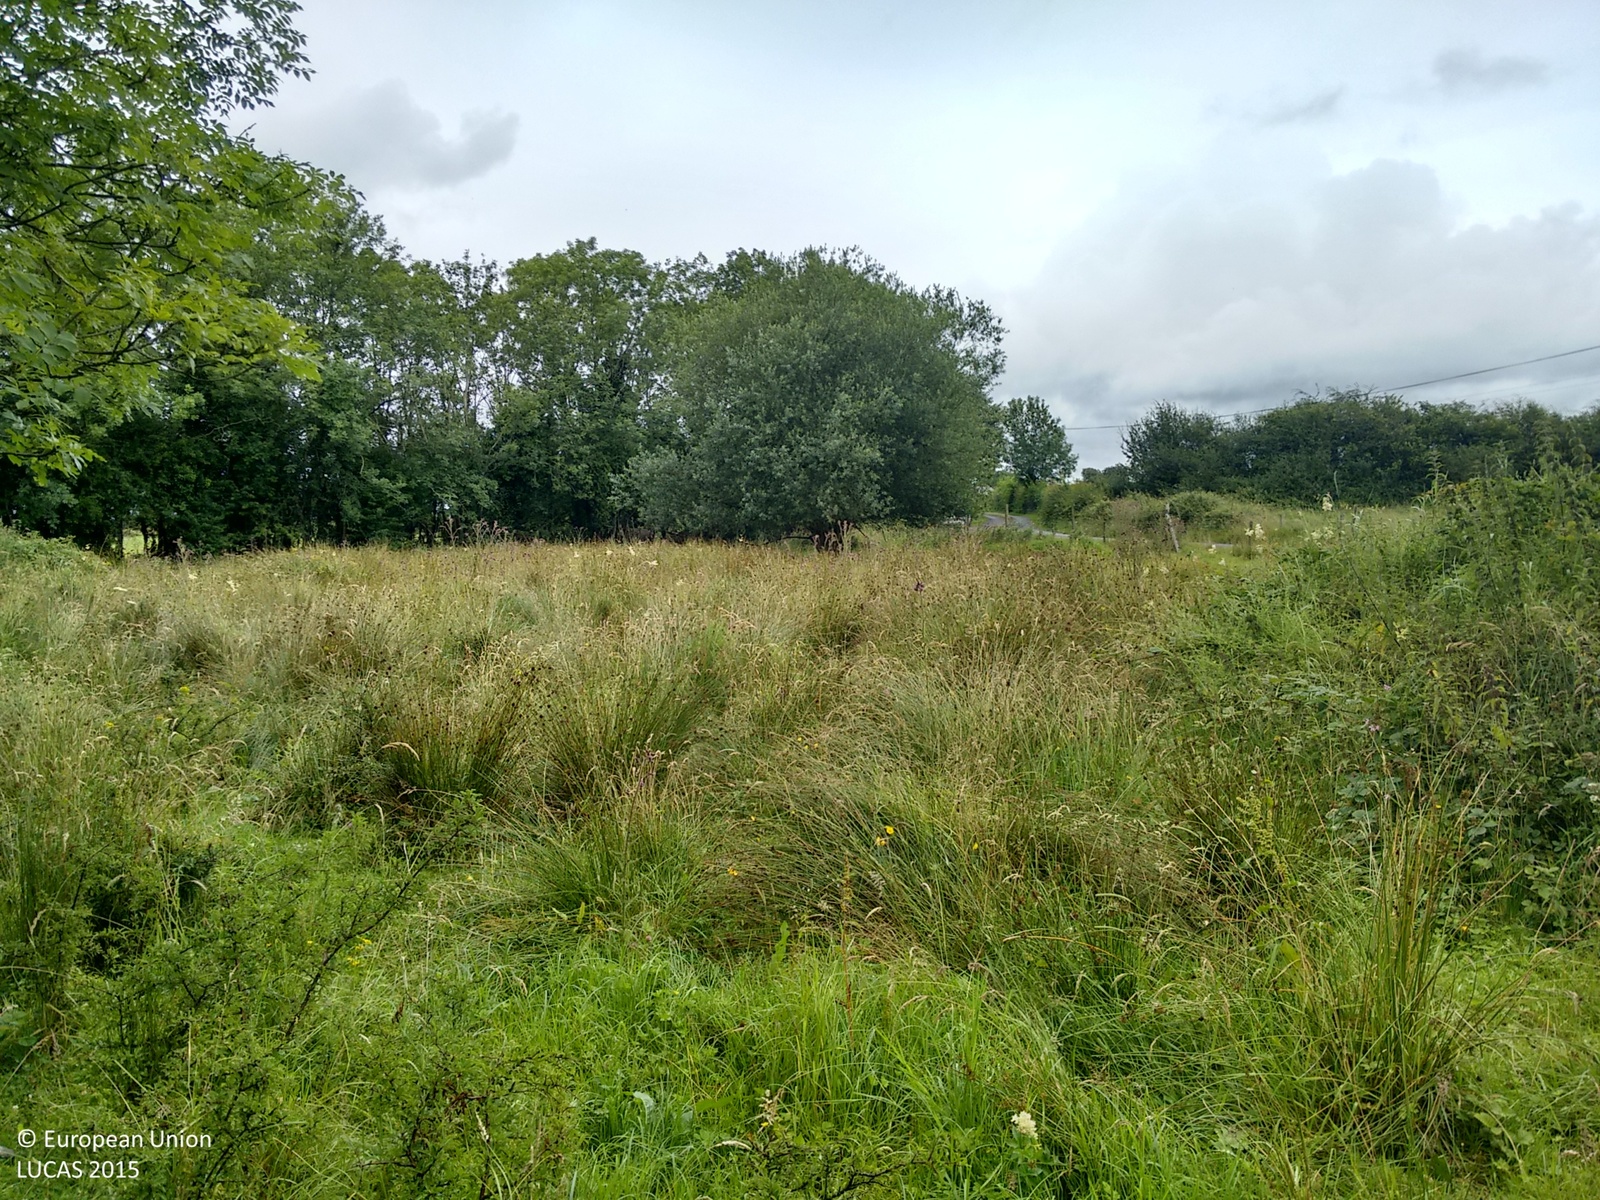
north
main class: Grassland
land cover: Grassland without tree/shrub cover
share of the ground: > 75 %
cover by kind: herbaceous plants 95 %, shrubs 5 %
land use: Agriculture (excluding fallow land and kitchen gardens)
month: July
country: IE
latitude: 53.7495
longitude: -7.8987
